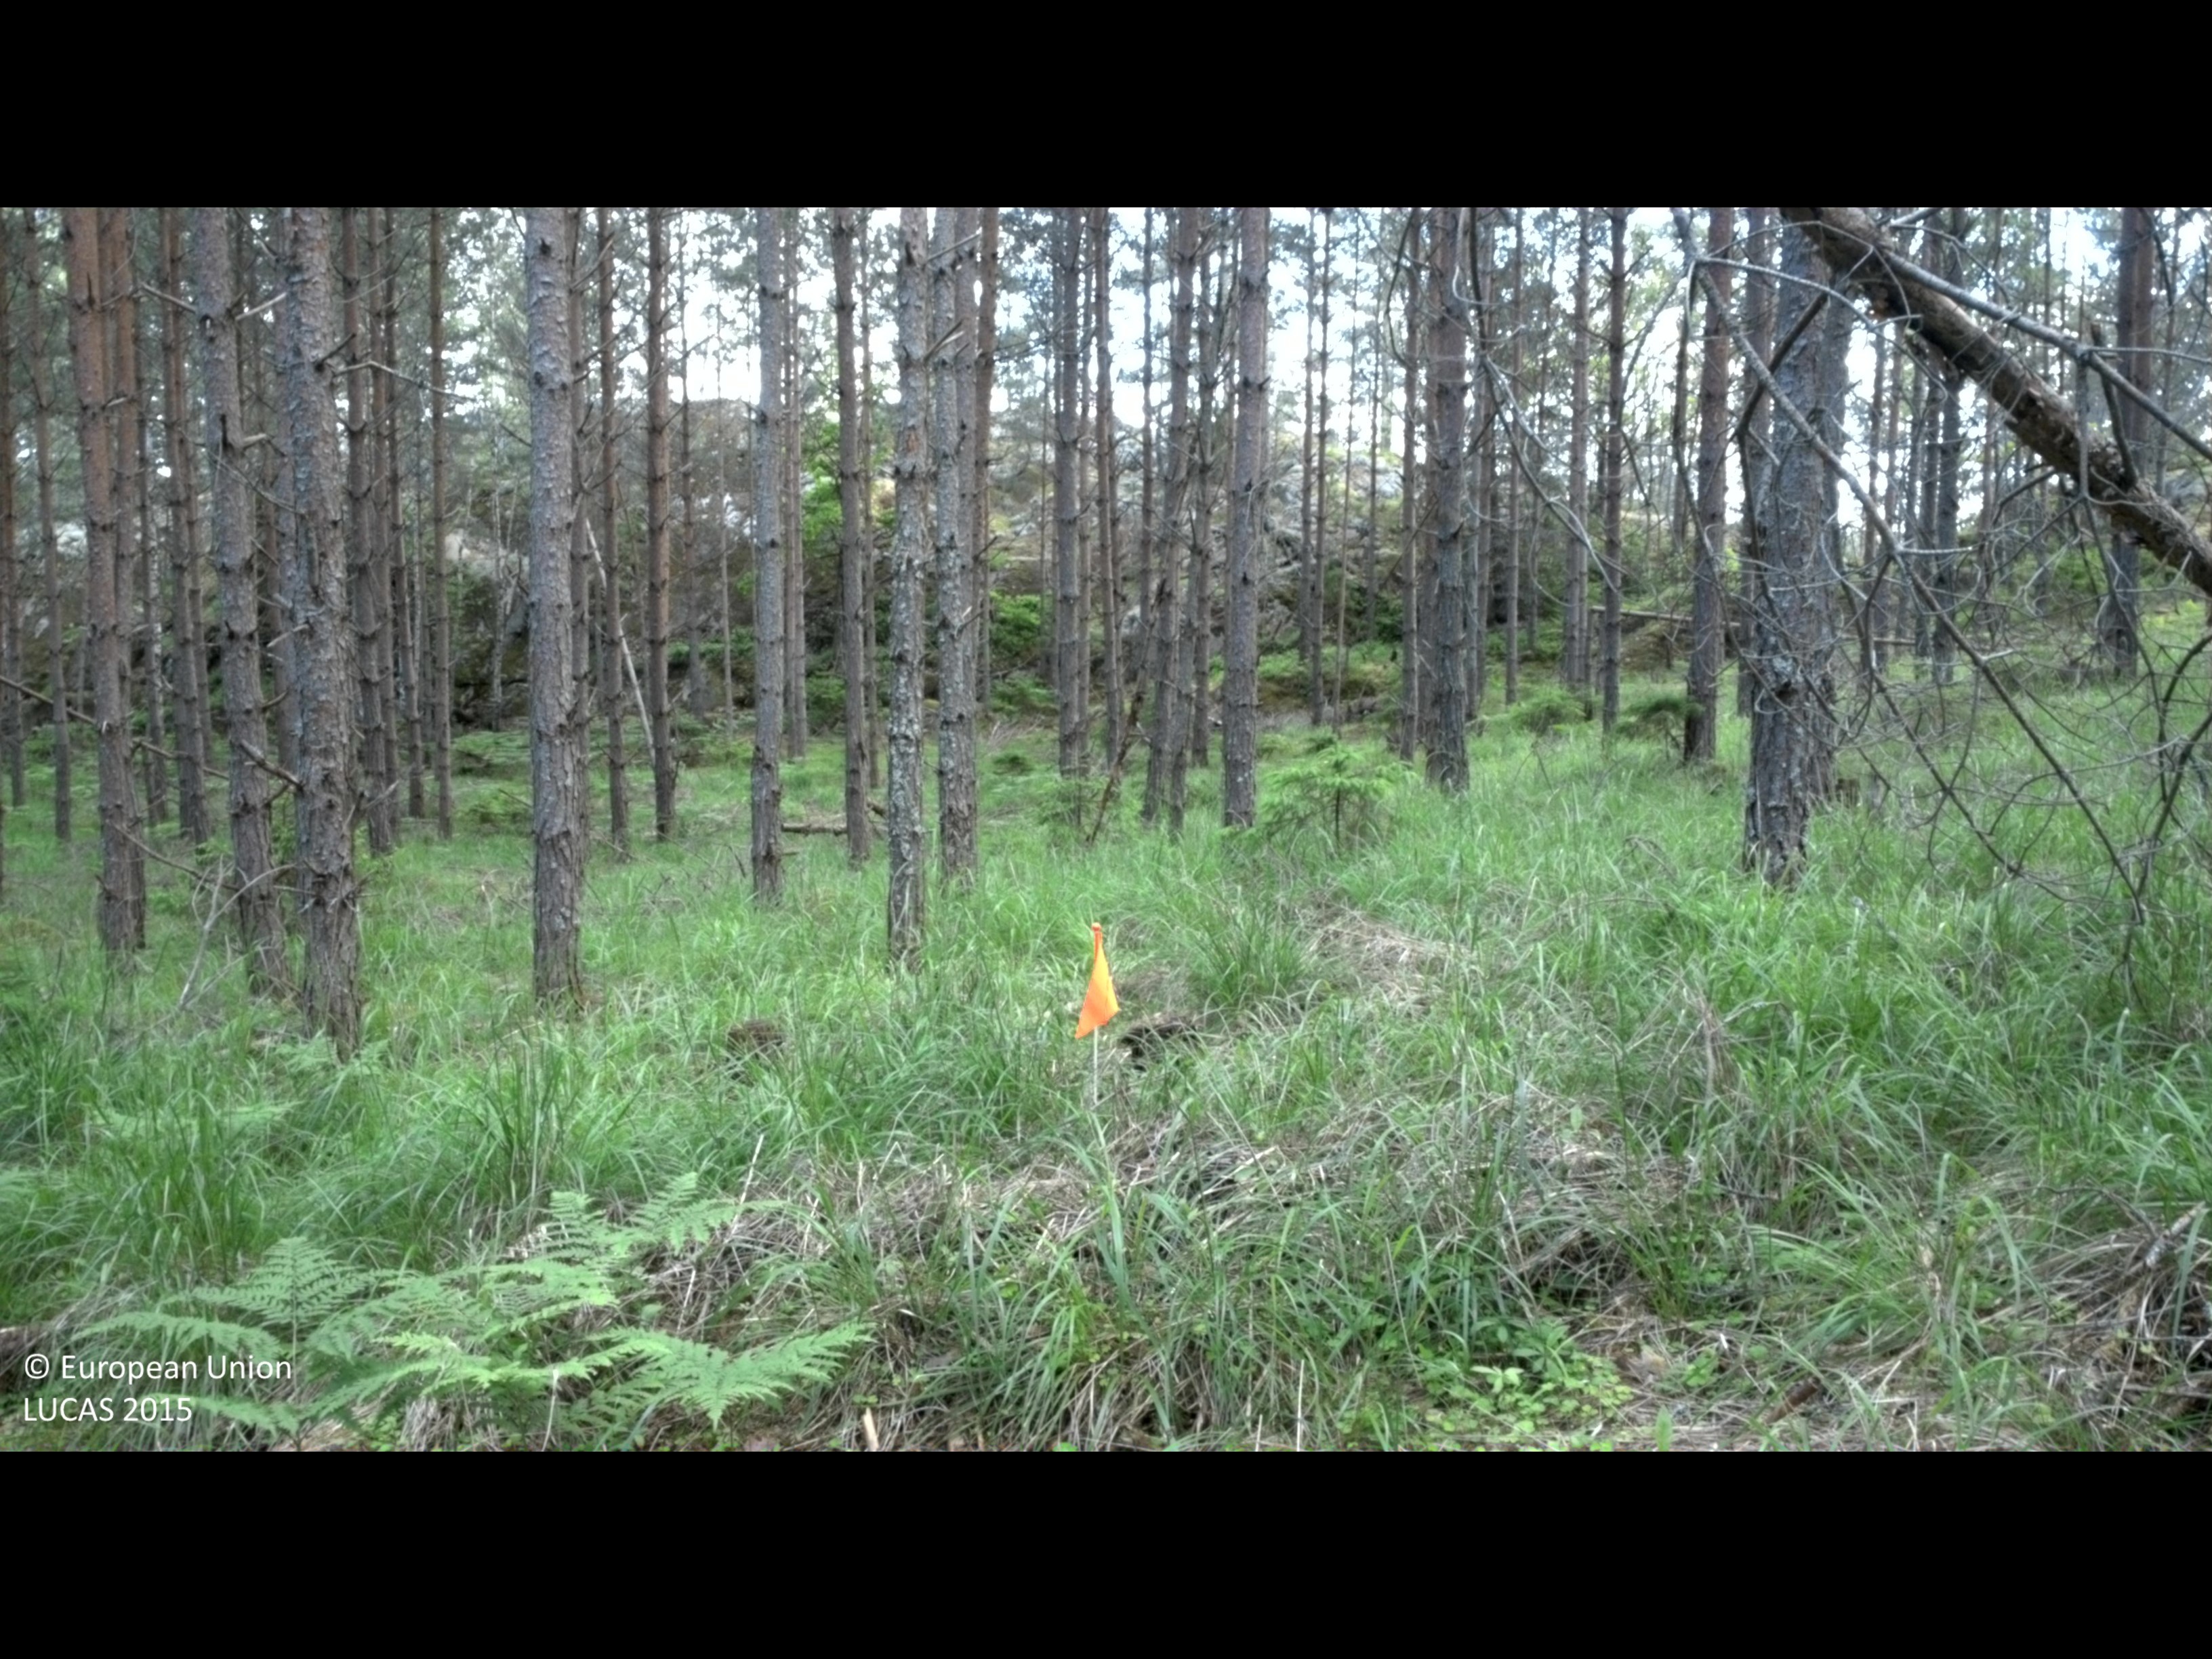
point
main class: Woodland
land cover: Pine dominated coniferous woodland
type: boreal forest
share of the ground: 50 - 75 %
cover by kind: coniferous forest trees 70 %, herbaceous plants 25 %, broadleaved forest trees 5 %
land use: Forestry
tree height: > 5 m
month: June
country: SE
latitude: 57.9892
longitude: 16.1366
